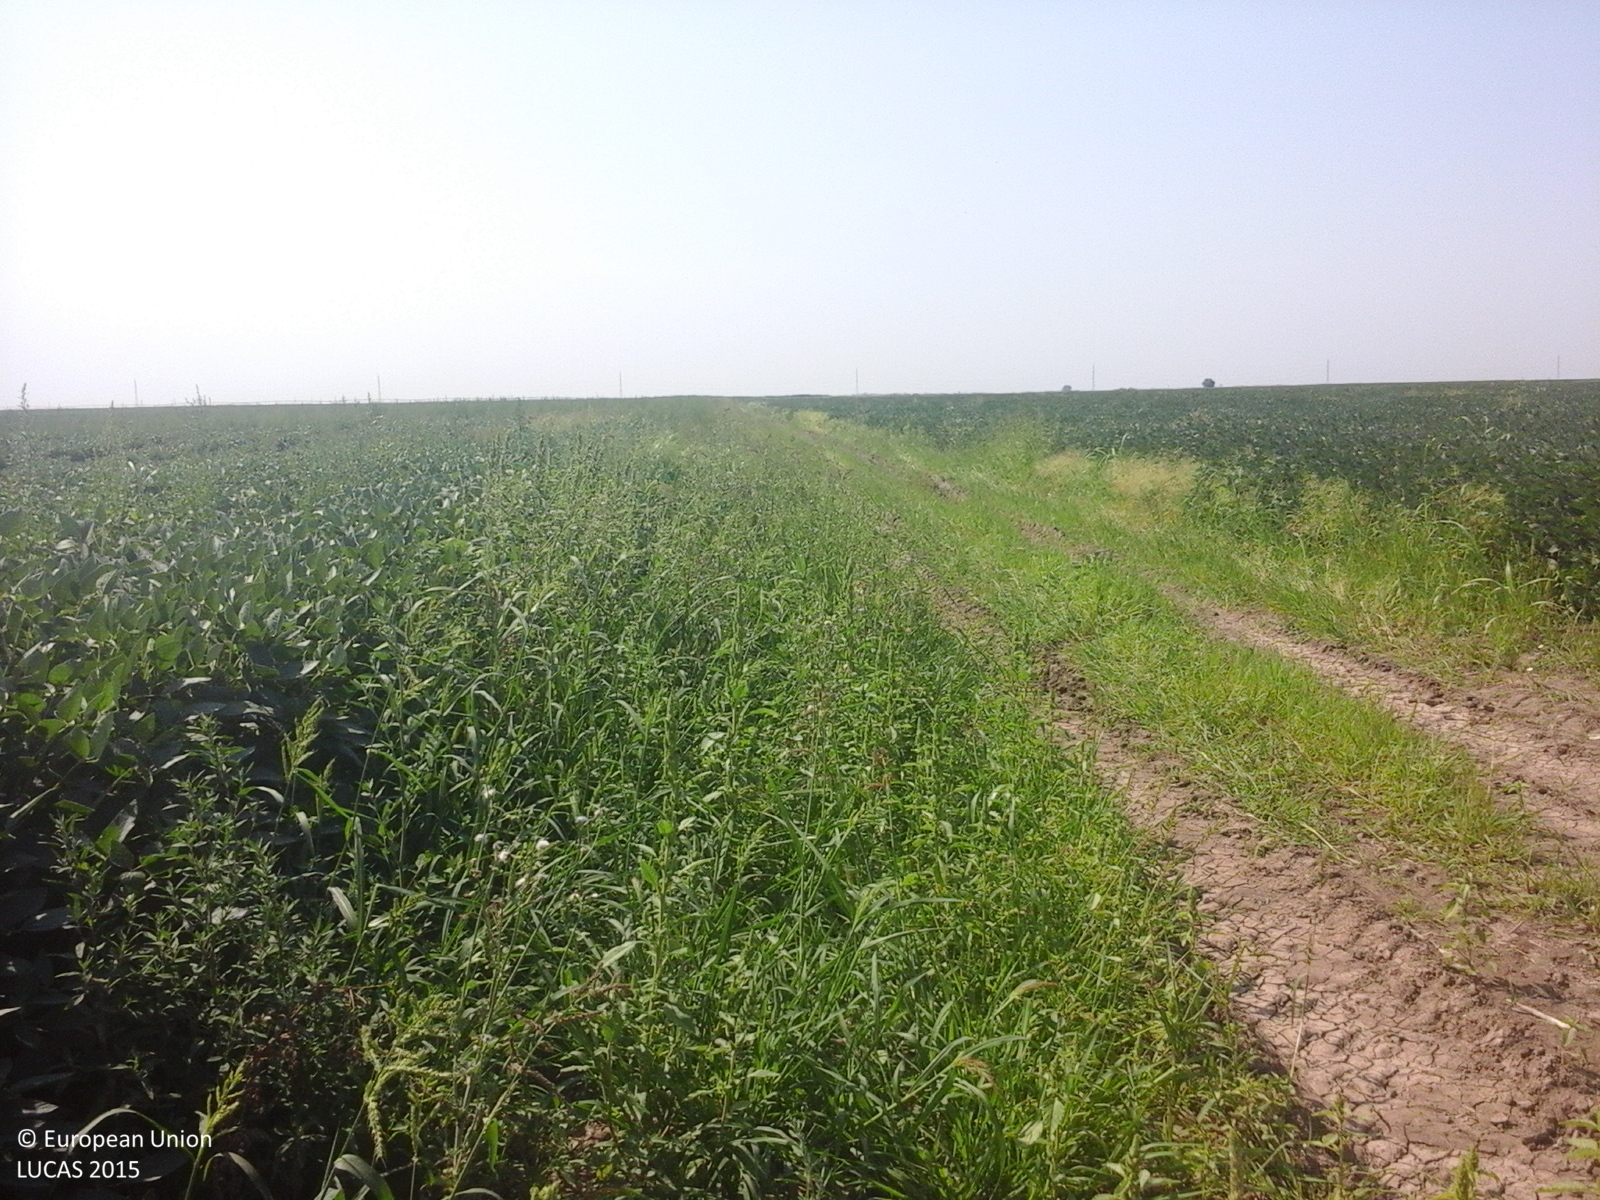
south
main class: Cropland
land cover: Soya
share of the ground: > 75 %
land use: Agriculture (excluding fallow land and kitchen gardens)
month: August
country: RO
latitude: 45.1559
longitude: 28.0124
